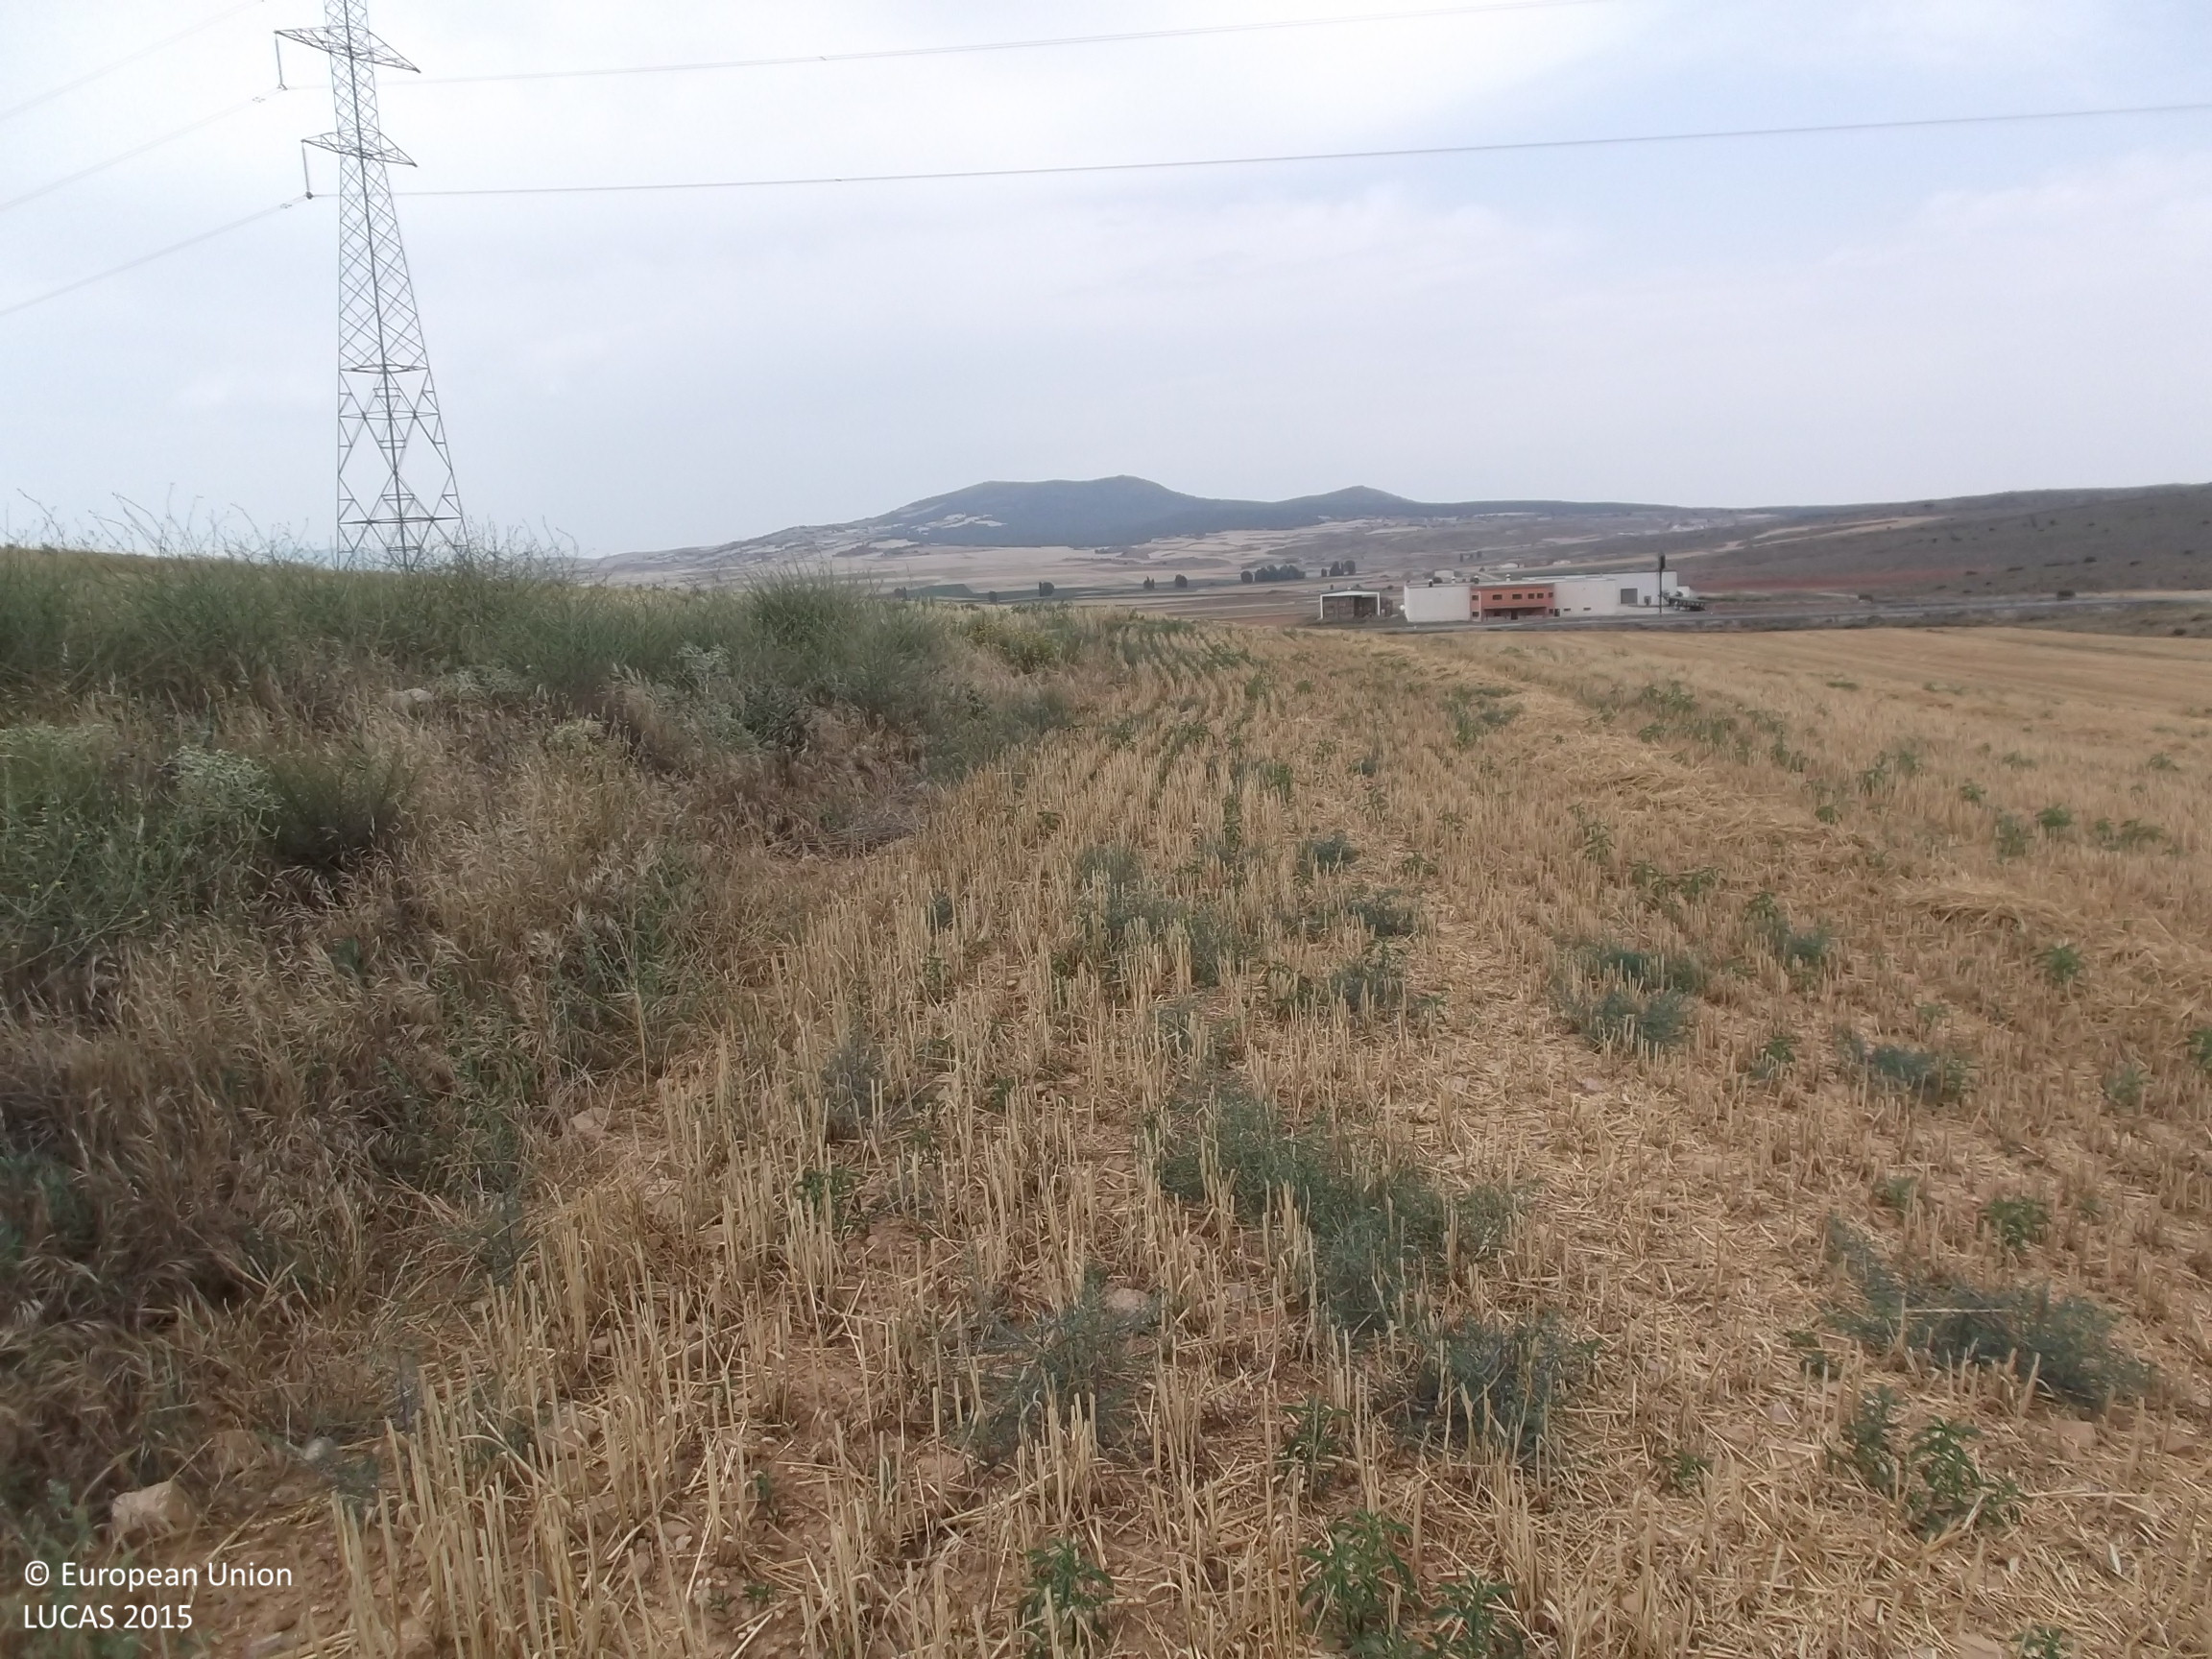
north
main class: Cropland
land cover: Common wheat
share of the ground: < 10 %
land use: Agriculture (excluding fallow land and kitchen gardens)
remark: Harvested field
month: July
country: ES
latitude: 41.8474
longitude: -1.9934
